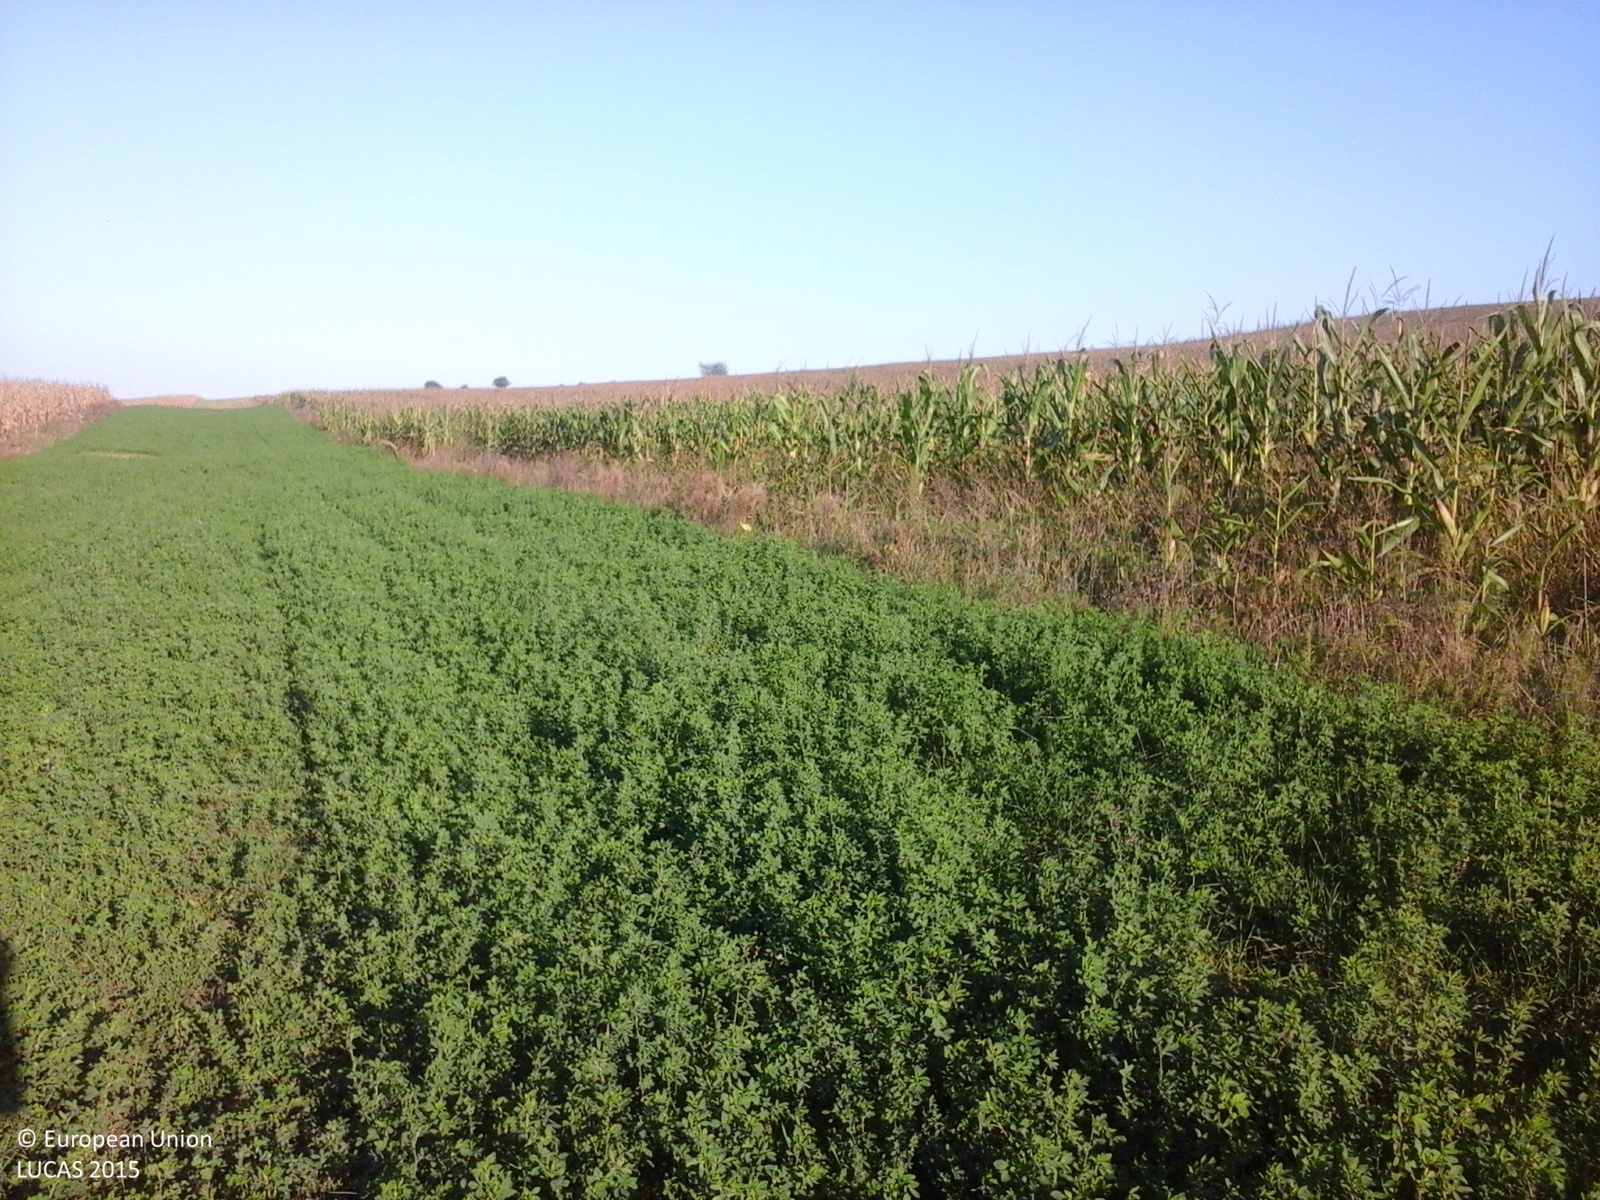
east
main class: Cropland
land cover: Lucerne
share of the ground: > 75 %
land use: Agriculture (excluding fallow land and kitchen gardens)
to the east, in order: Lucerne; Maize
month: October
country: RO
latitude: 46.2127
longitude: 23.9831
